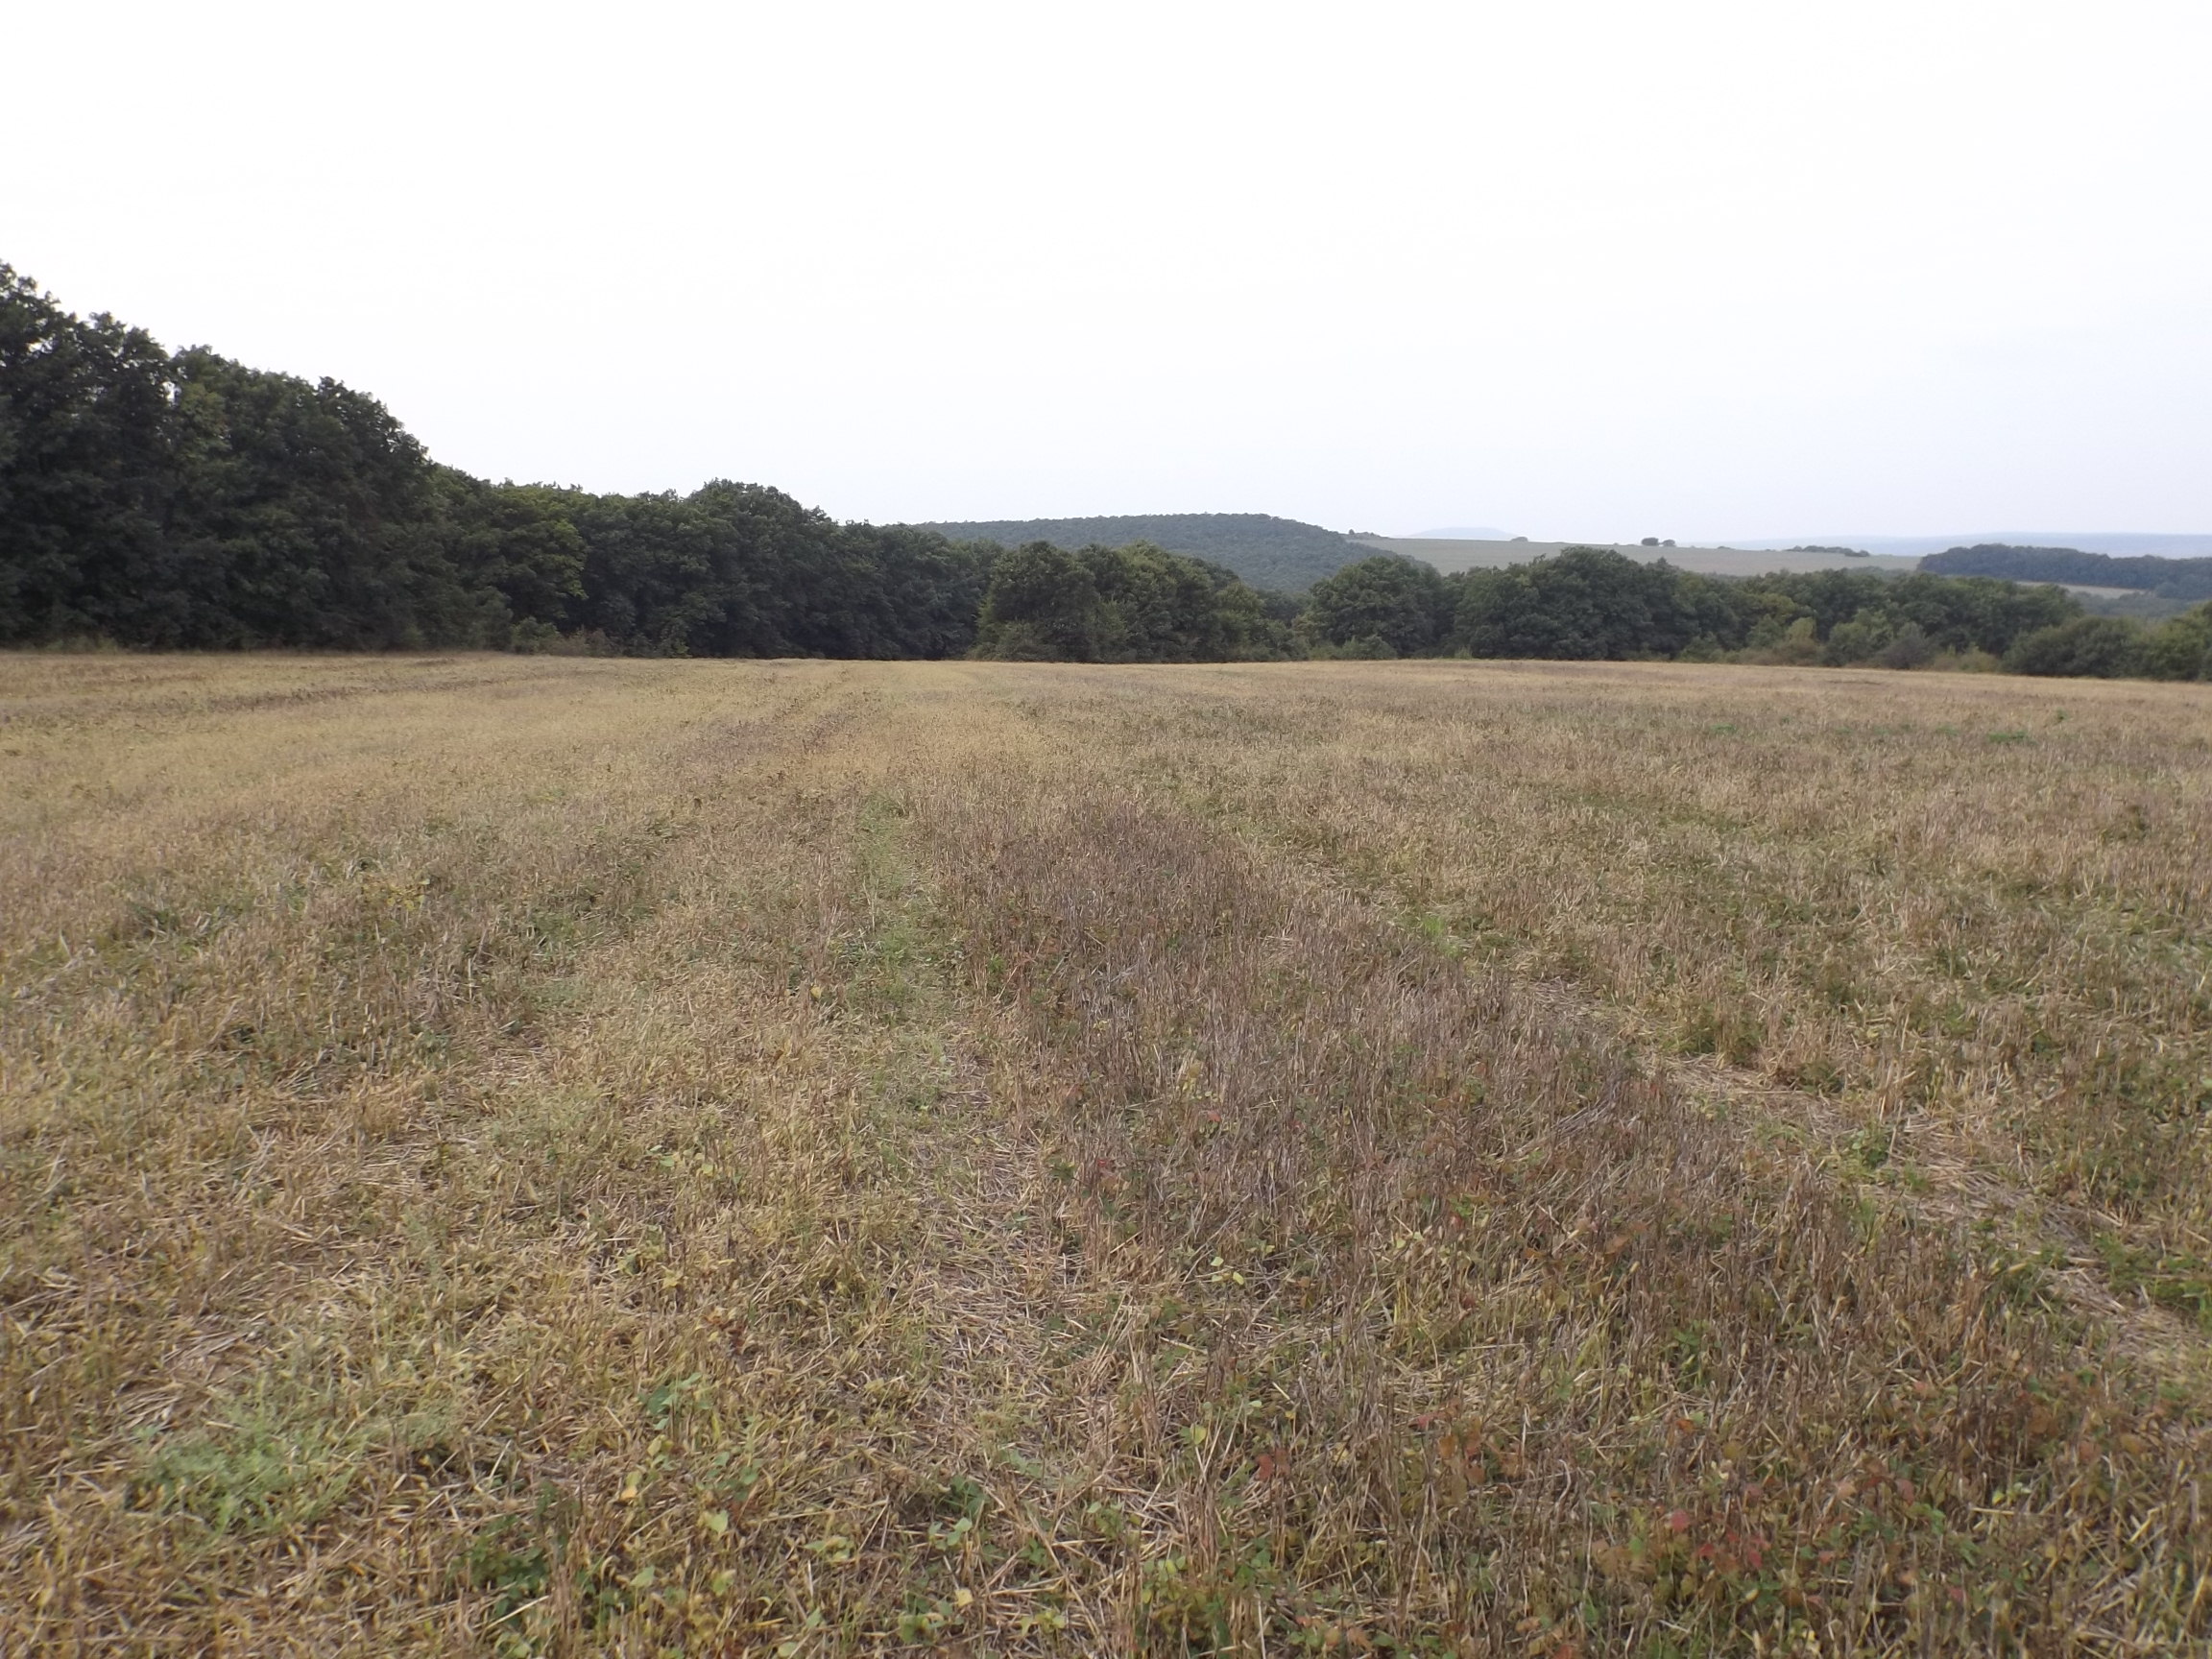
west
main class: Cropland
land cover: Common wheat
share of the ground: 10 - 25 %
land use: Agriculture (excluding fallow land and kitchen gardens)
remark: Harvested field
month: October
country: BG
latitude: 43.0206
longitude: 27.3616
